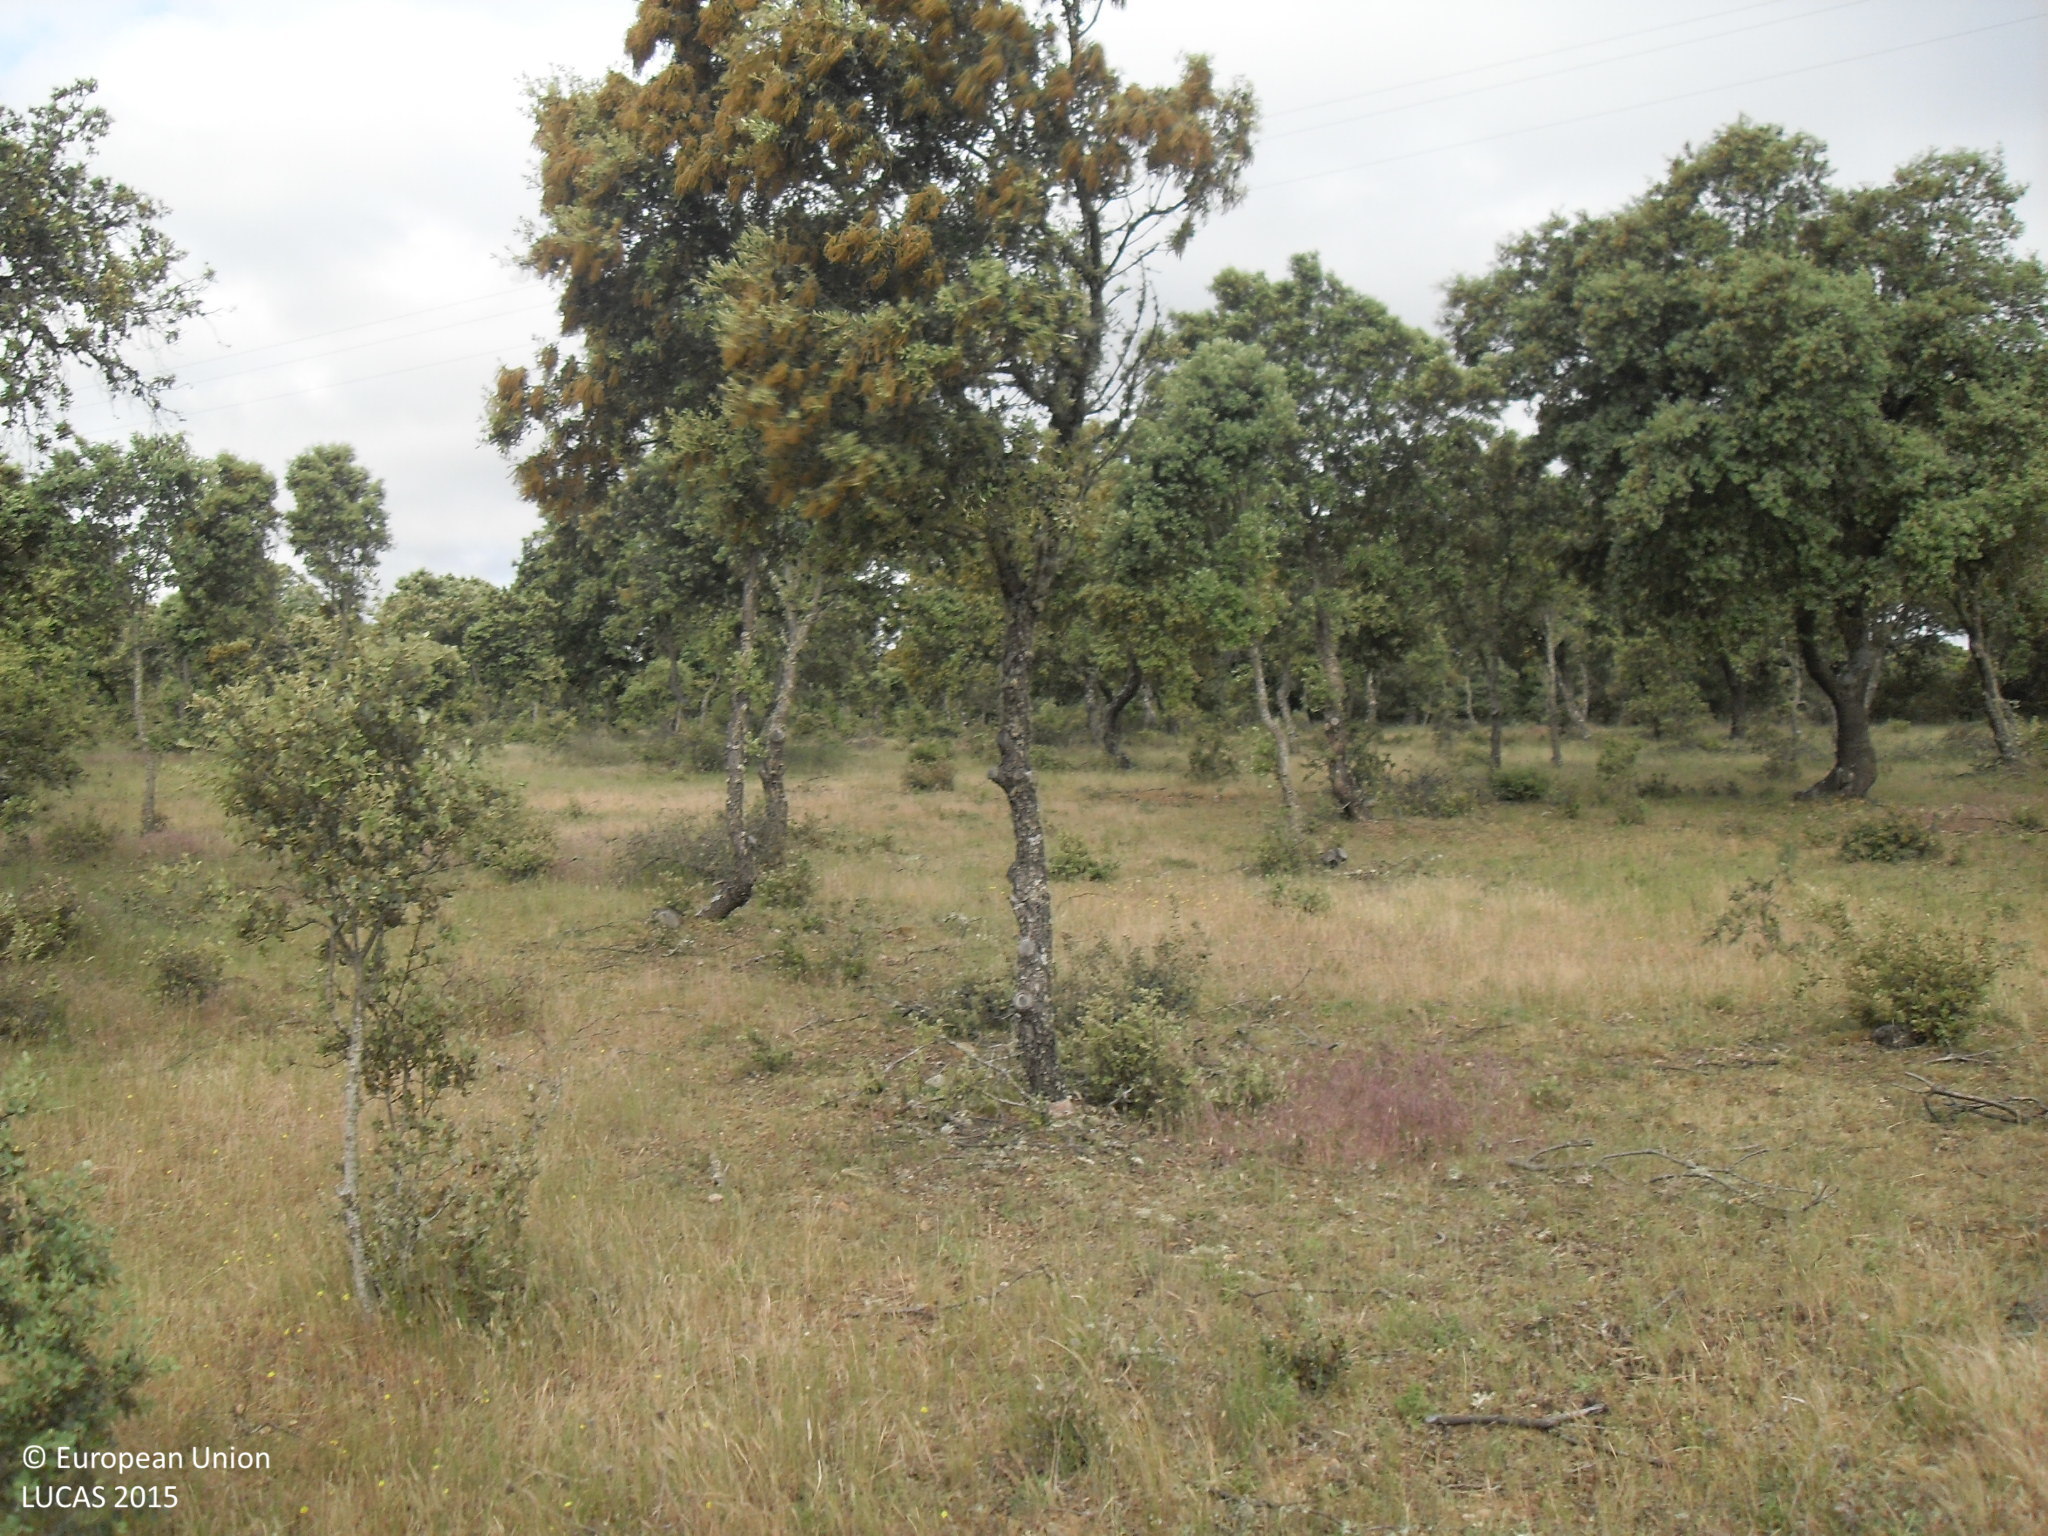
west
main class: Woodland
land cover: Broadleaved woodland
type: broadleaved evergreen forest
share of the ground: > 75 %
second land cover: Grassland without tree/shrub cover
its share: 10 - 25 %
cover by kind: broadleaved forest trees 80 %, herbaceous plants 20 %
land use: Forestry
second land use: Agriculture (excluding fallow land and kitchen gardens)
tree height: > 5 m
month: May
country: ES
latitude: 40.7317
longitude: -5.6438
